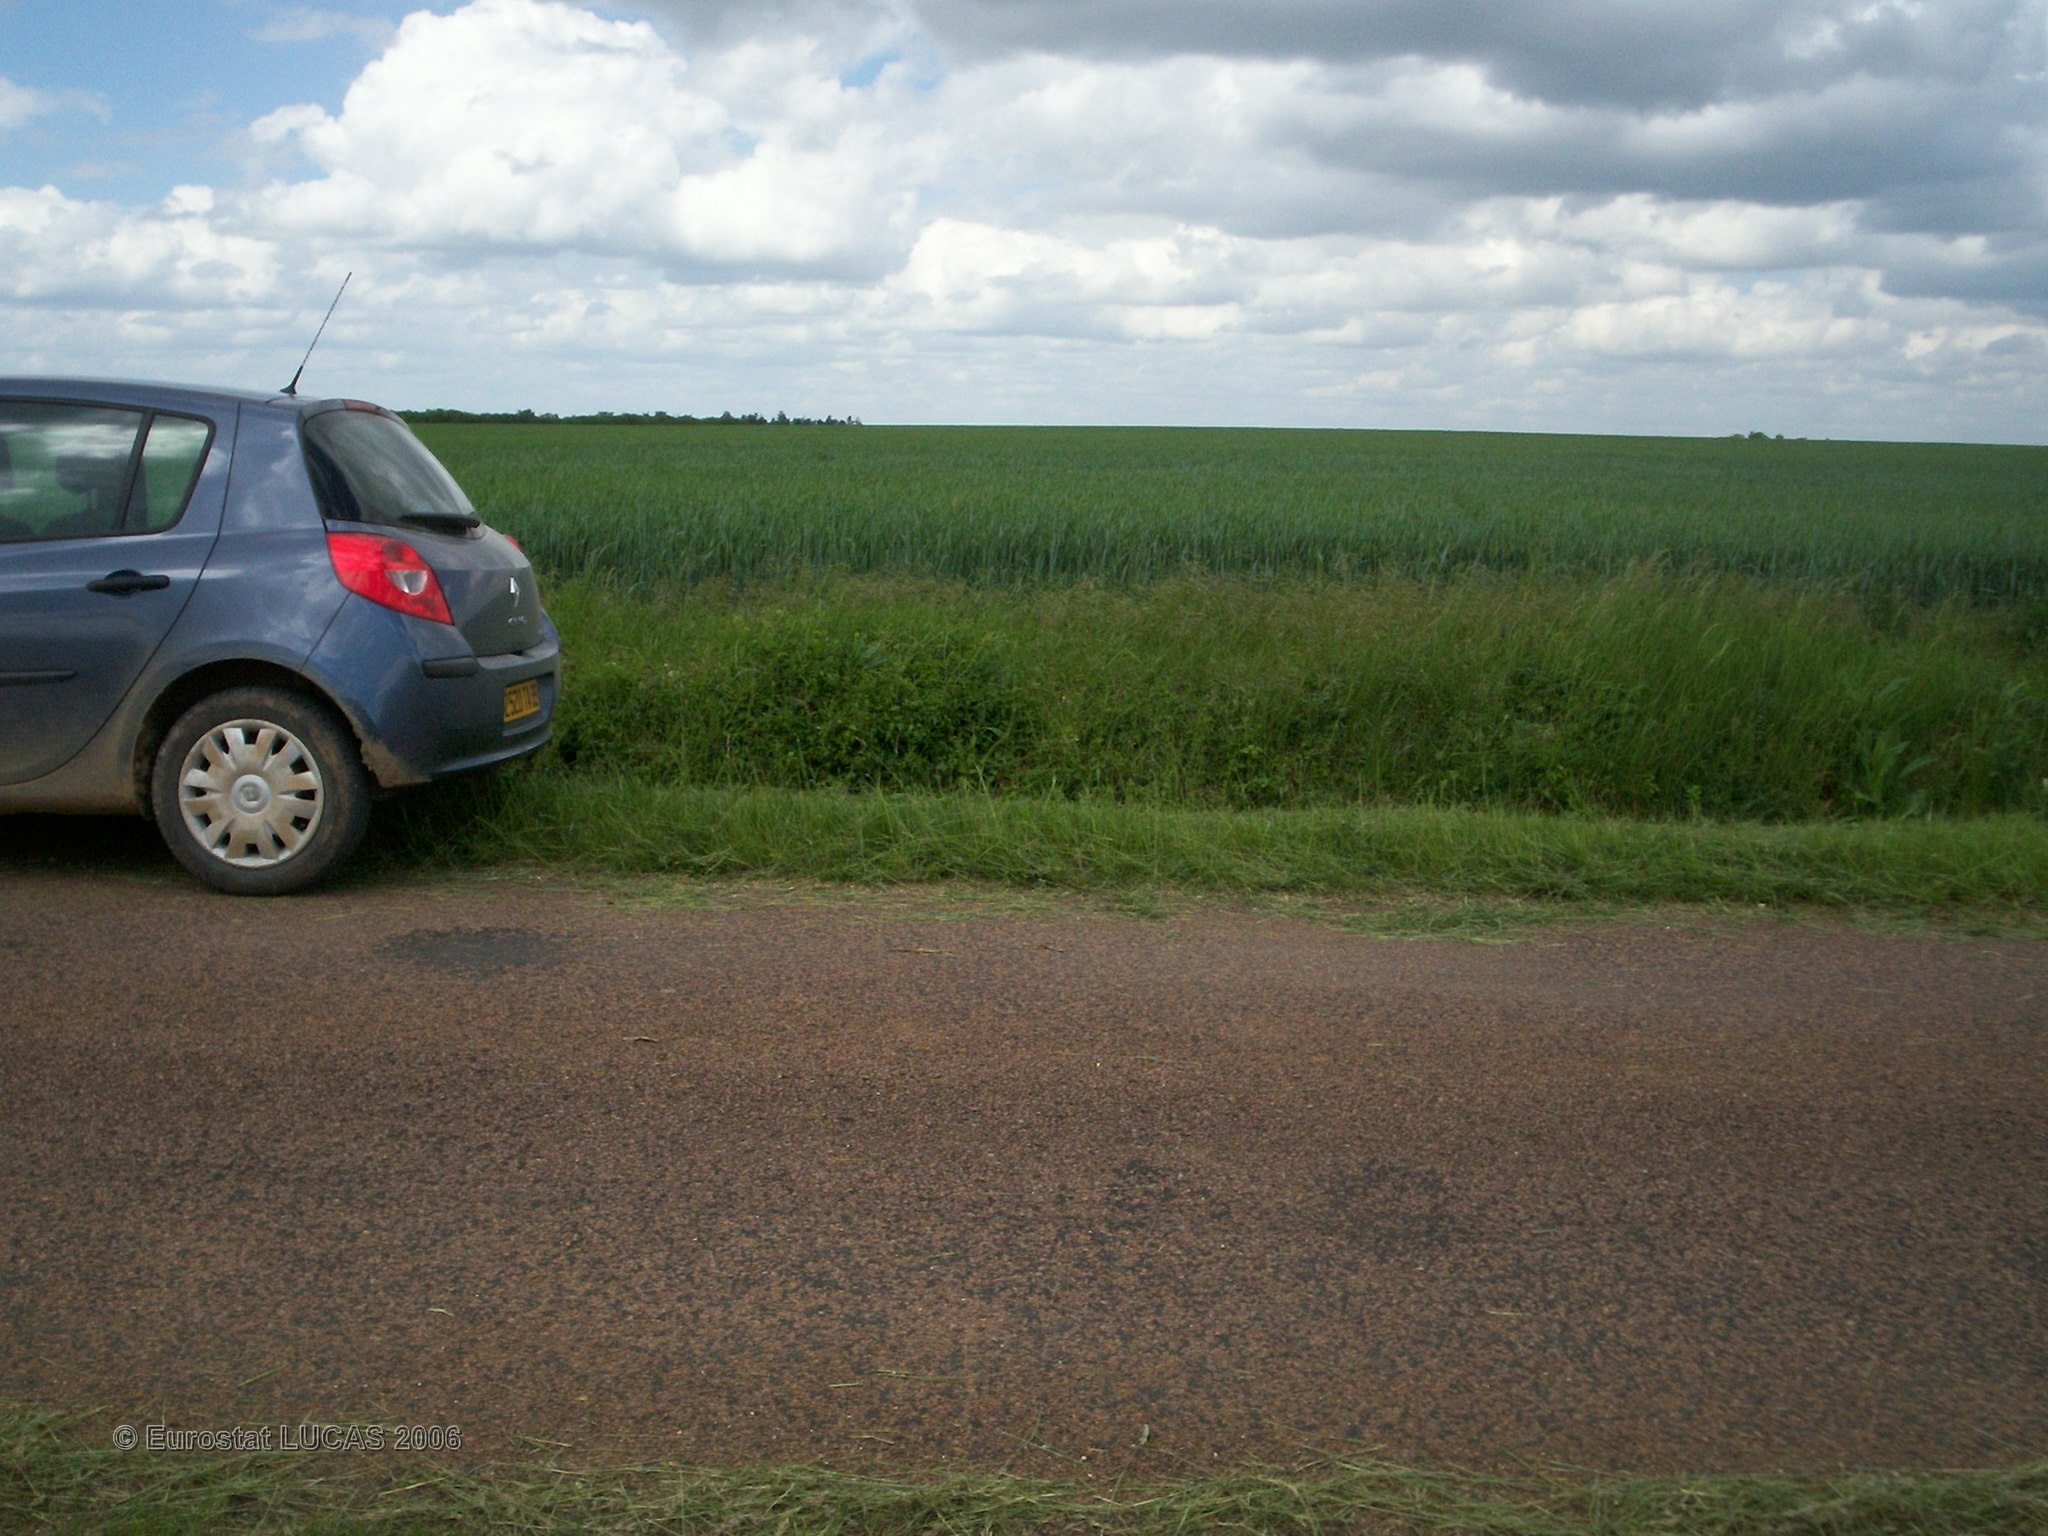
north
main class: Cropland
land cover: Rape and turnip rape
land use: Agriculture (excluding fallow land and kitchen gardens)
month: May
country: FR
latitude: 47.7567
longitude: 4.0610
